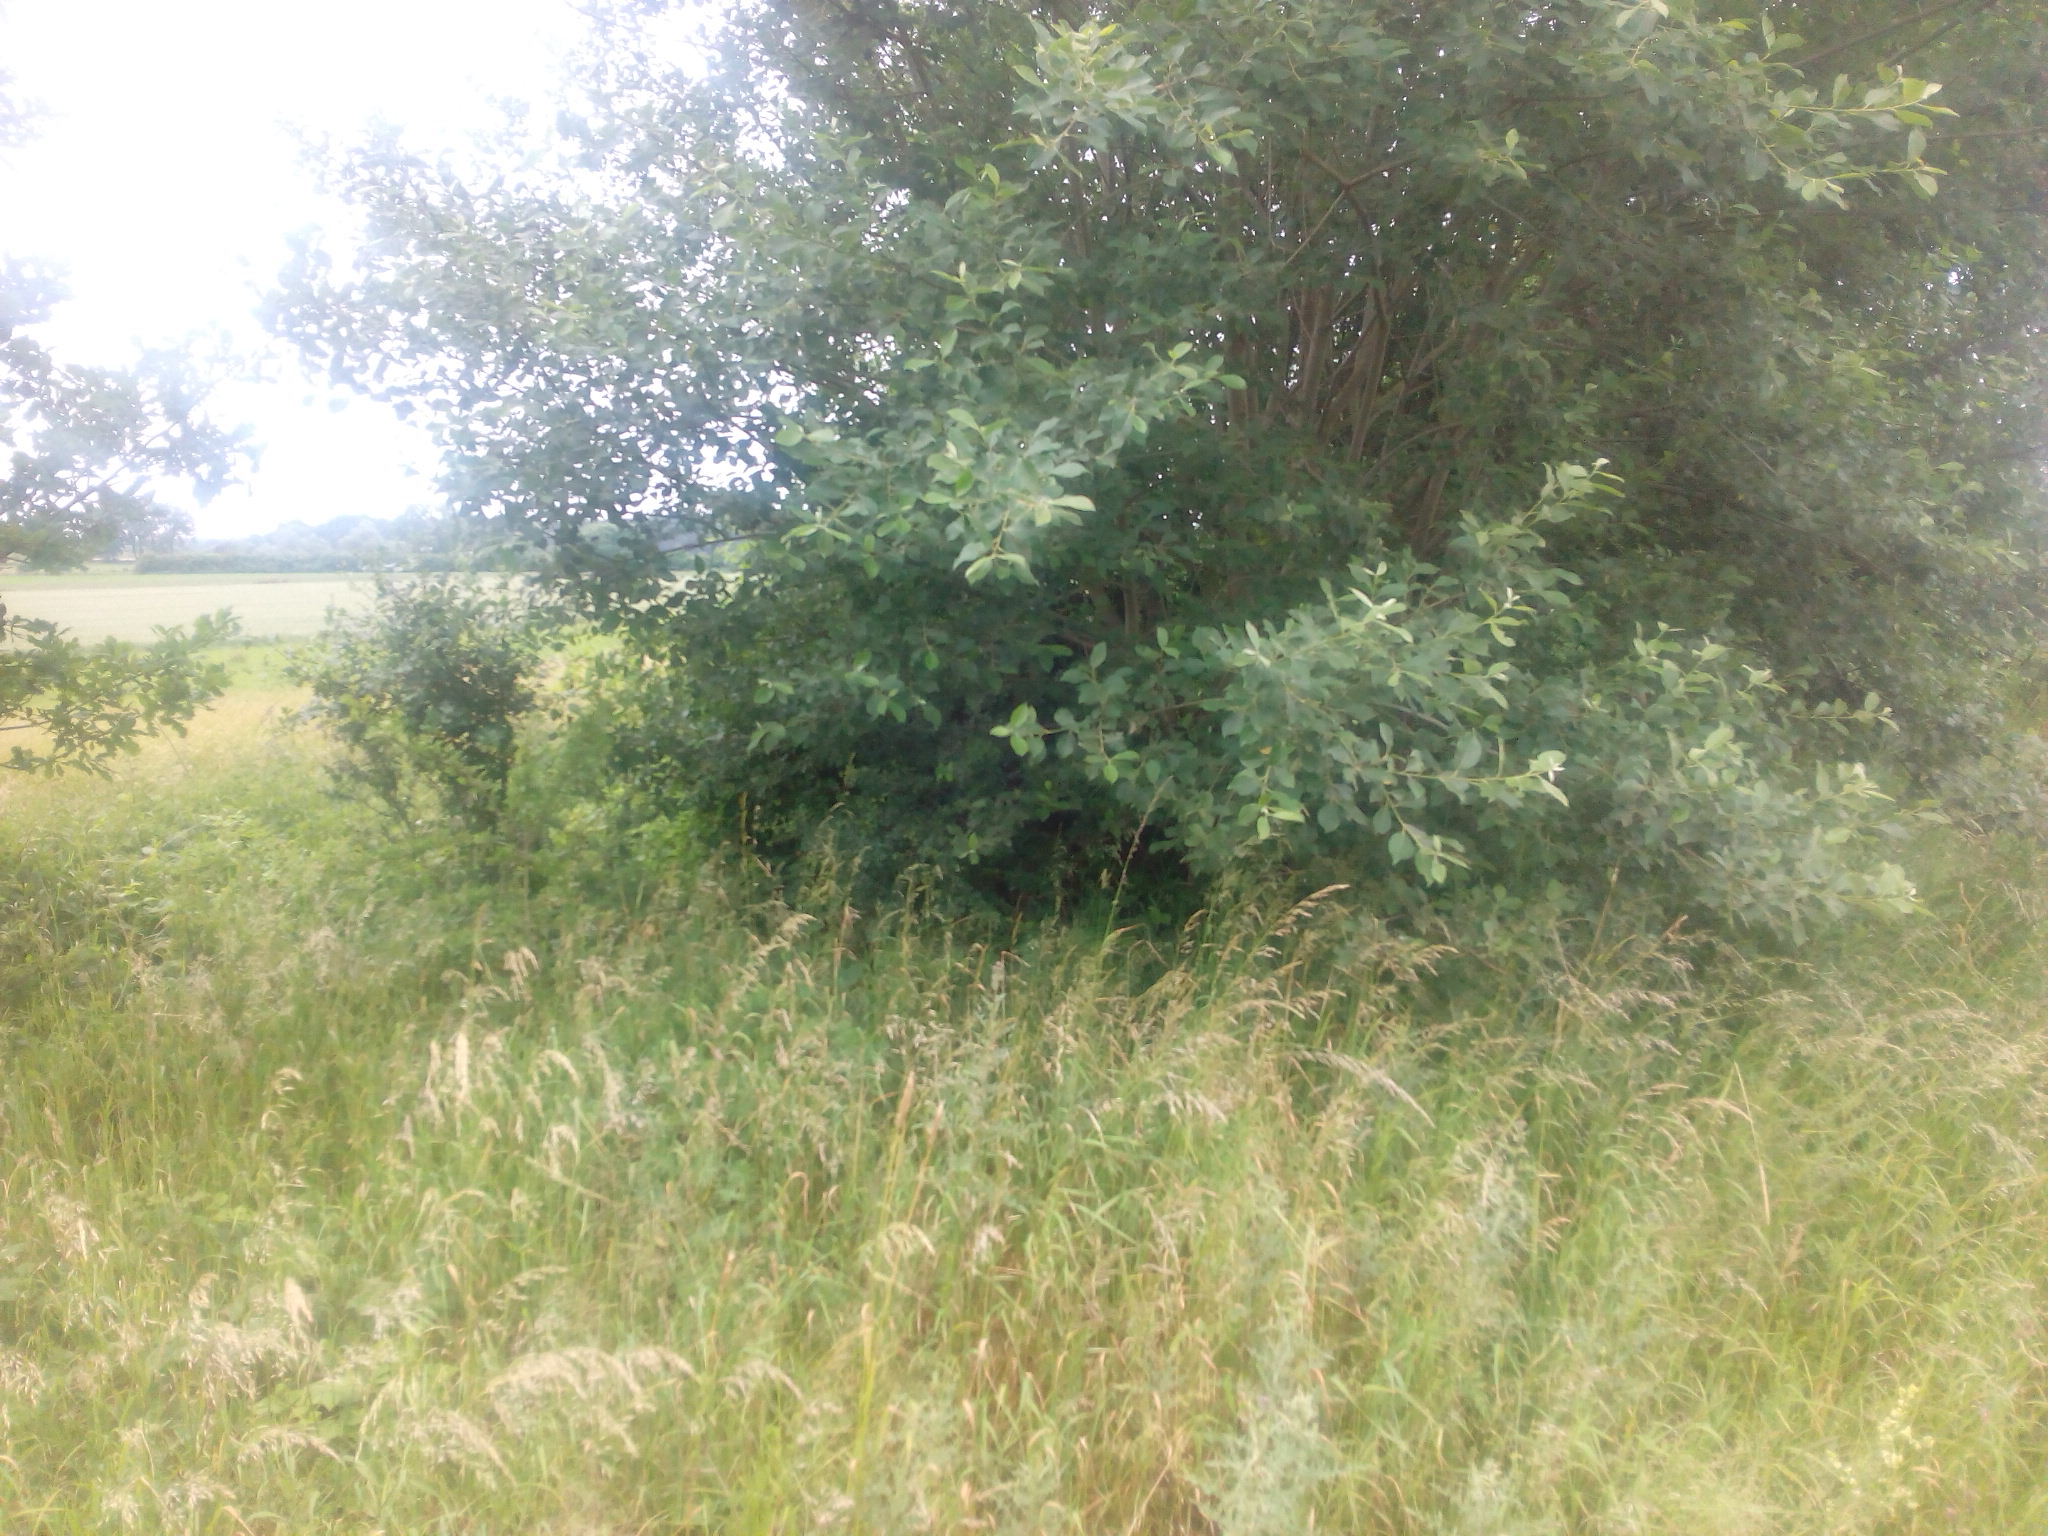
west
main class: Grassland
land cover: Grassland with sparse tree/shrub cover
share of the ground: > 75 %
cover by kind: herbaceous plants 85 %, shrubs 10 %, broadleaved forest trees 5 %
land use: Semi-natural and natural areas not in use
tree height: < 5 m
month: June
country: DE
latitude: 52.6105
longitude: 9.6014
